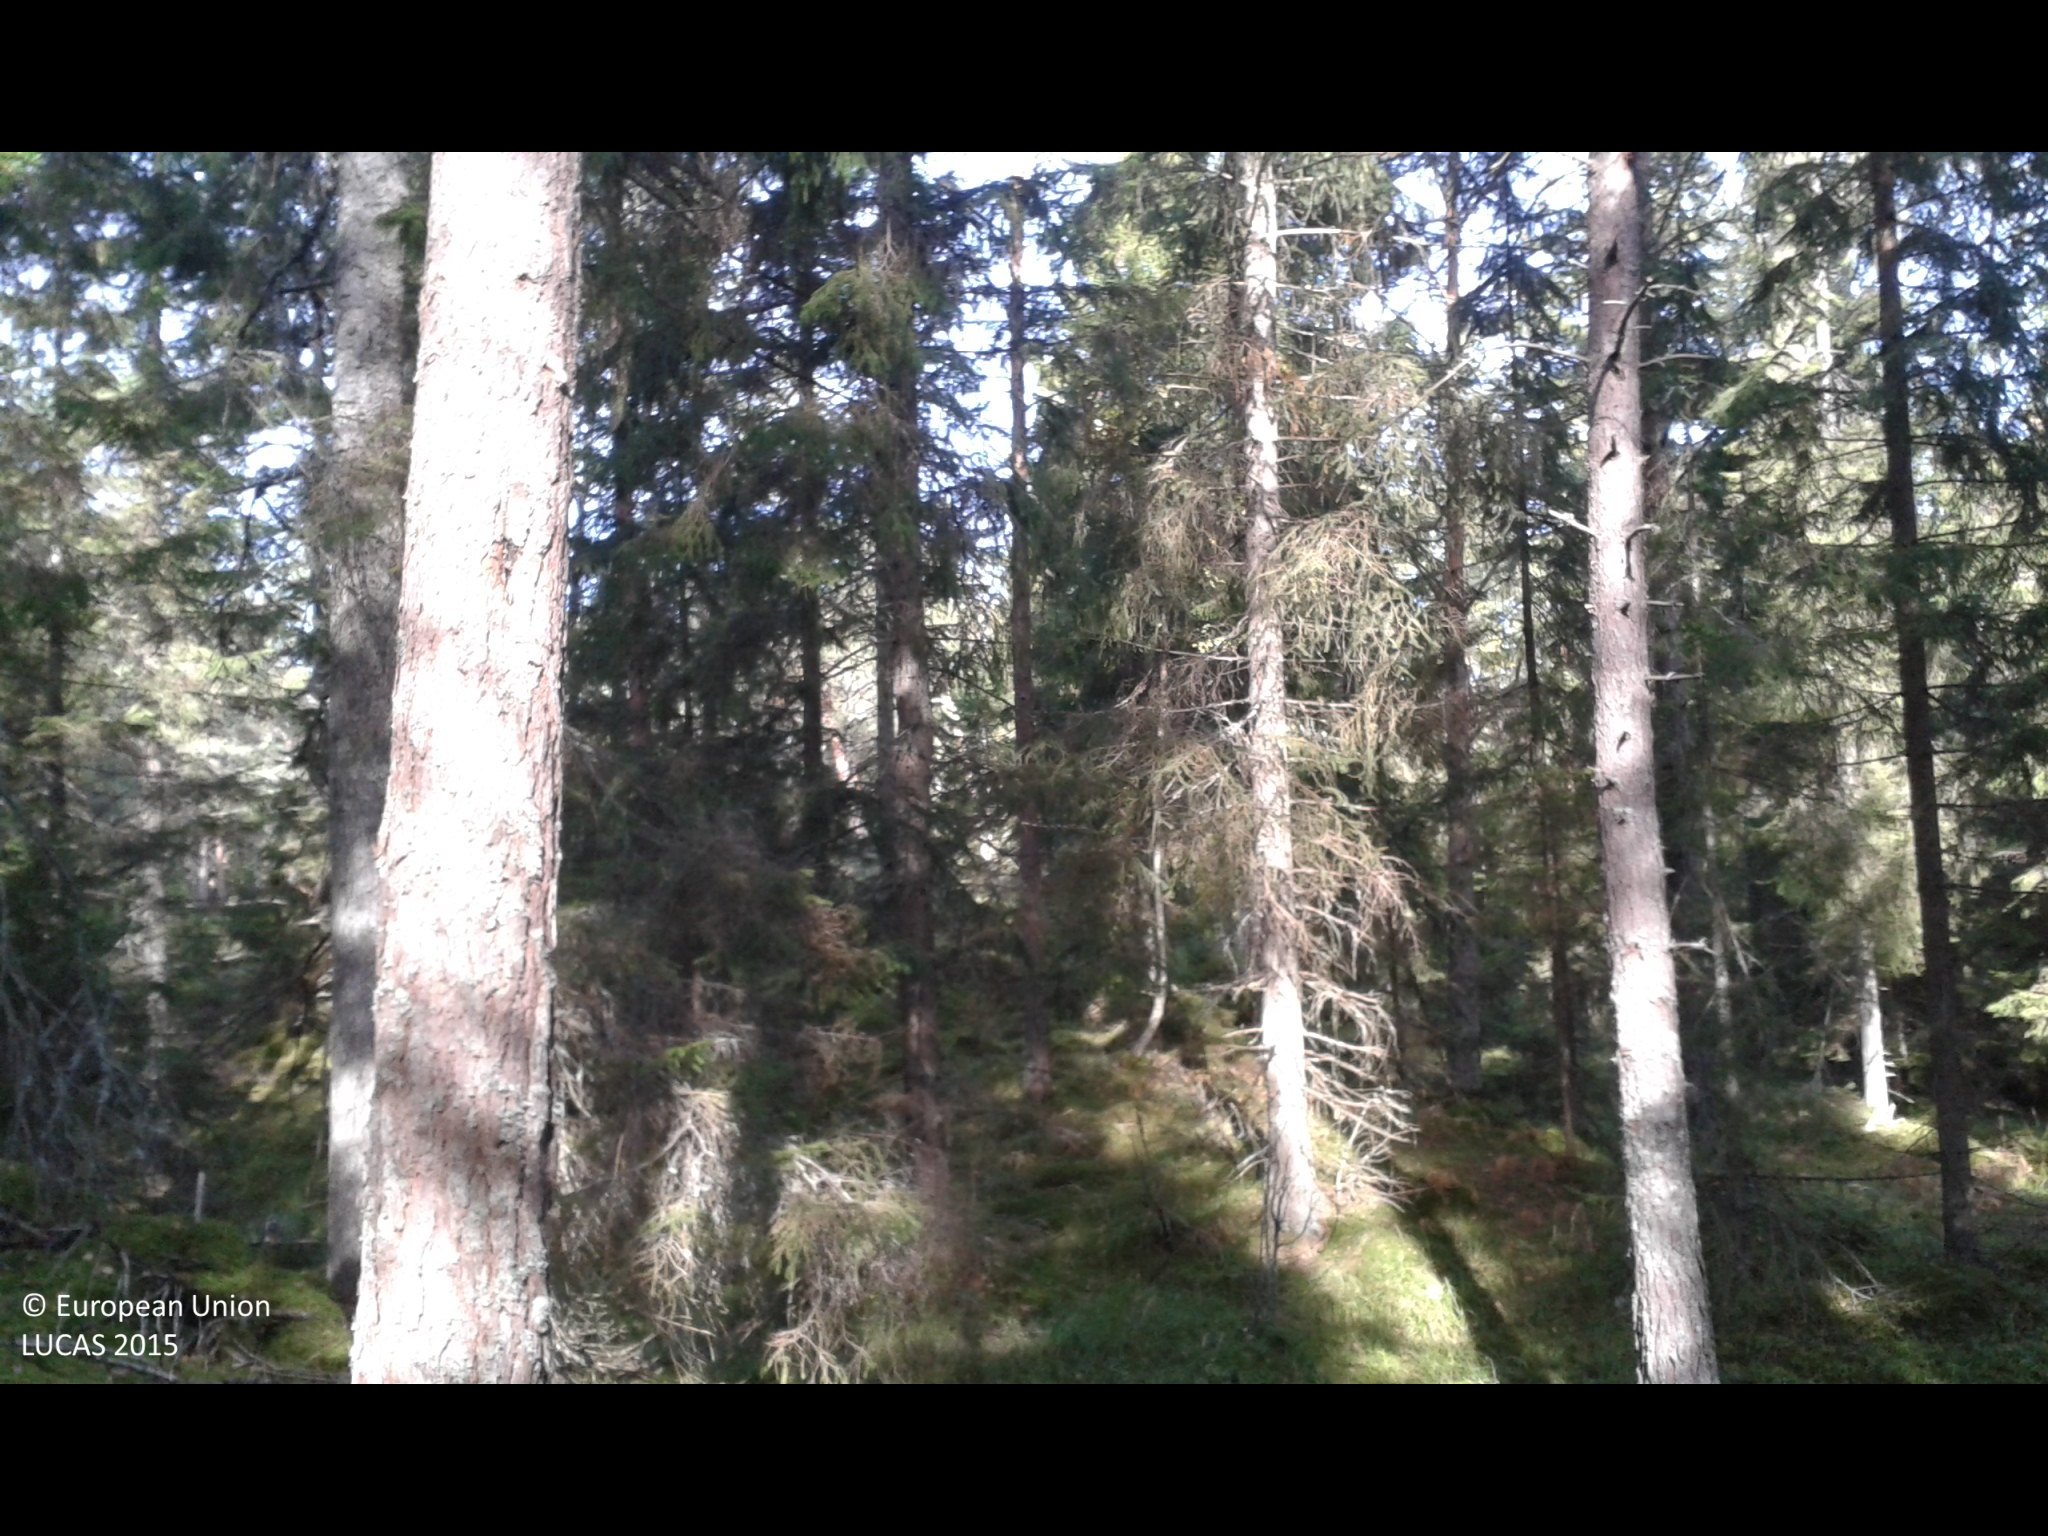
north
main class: Woodland
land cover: Spruce dominated coniferous woodland
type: boreal forest
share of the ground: > 75 %
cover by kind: coniferous forest trees 80 %, herbaceous plants 20 %
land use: Forestry
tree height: > 5 m
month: October
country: SE
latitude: 58.9186
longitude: 17.4130
